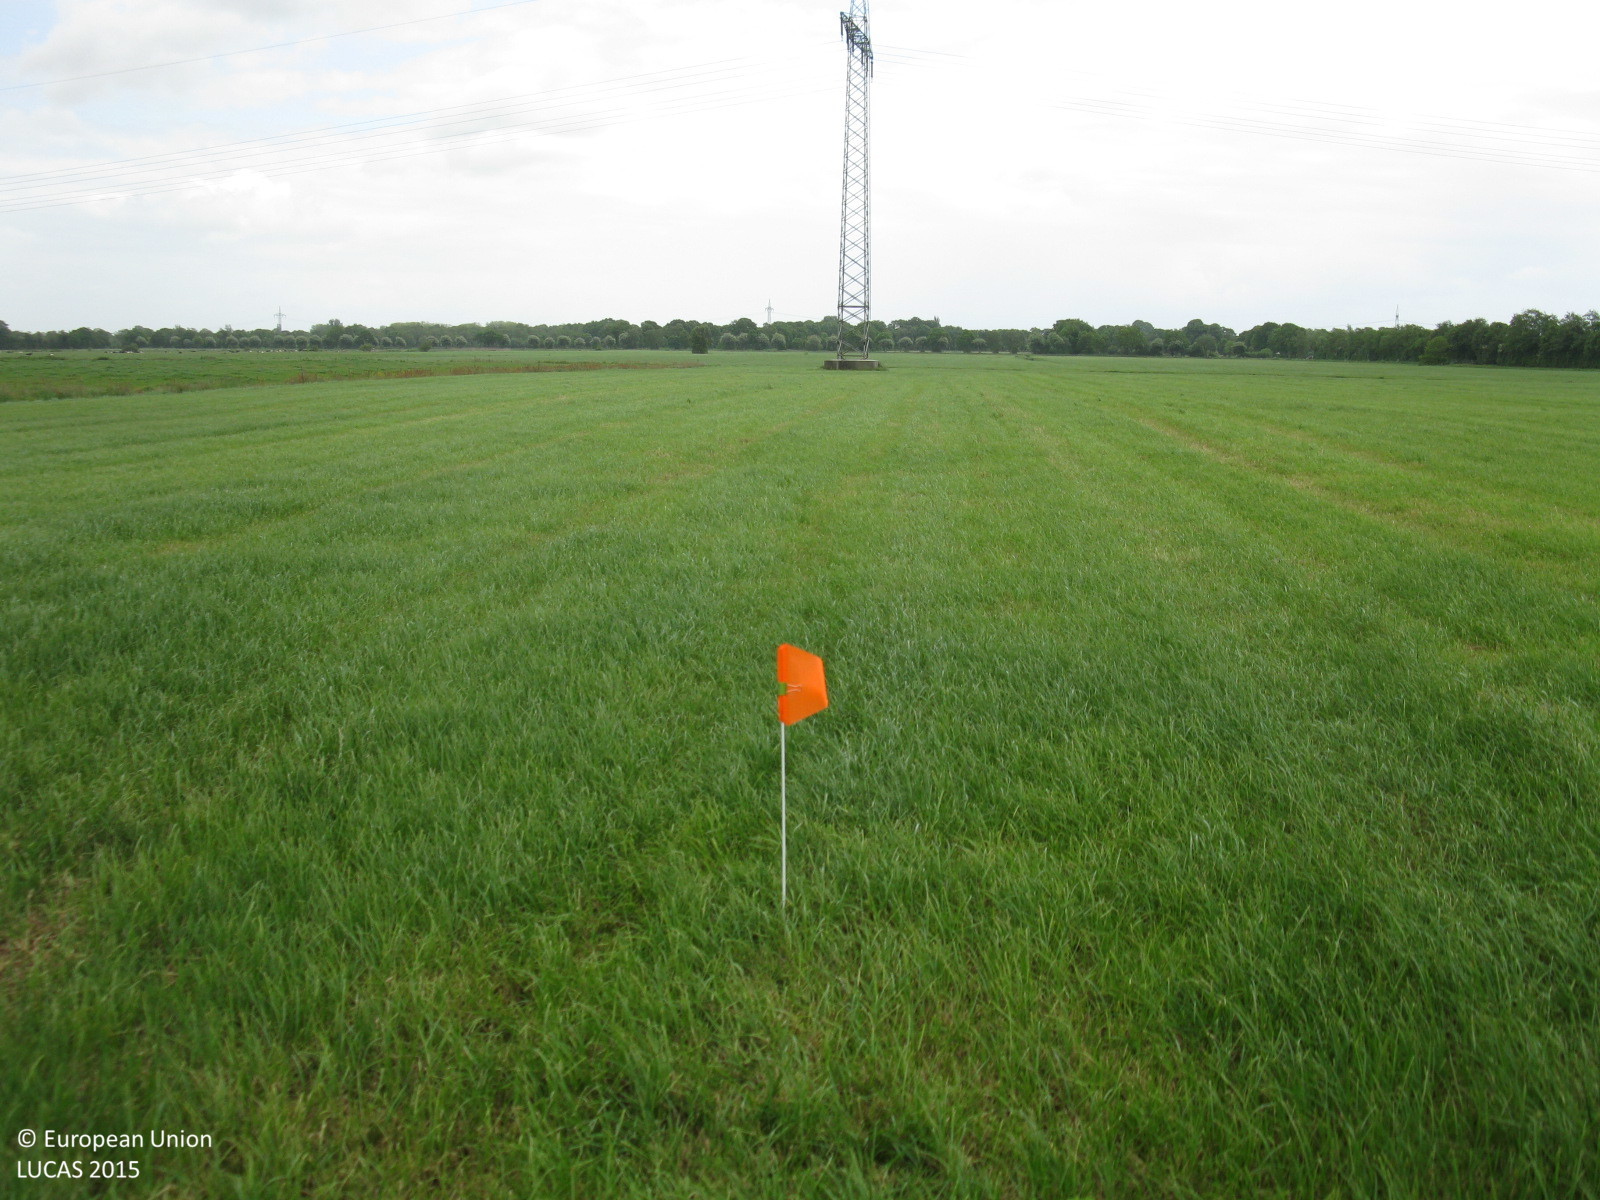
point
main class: Grassland
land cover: Grassland without tree/shrub cover
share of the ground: > 75 %
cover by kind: herbaceous plants 100 %
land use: Agriculture (excluding fallow land and kitchen gardens)
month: June
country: DE
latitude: 53.1406
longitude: 7.4143
